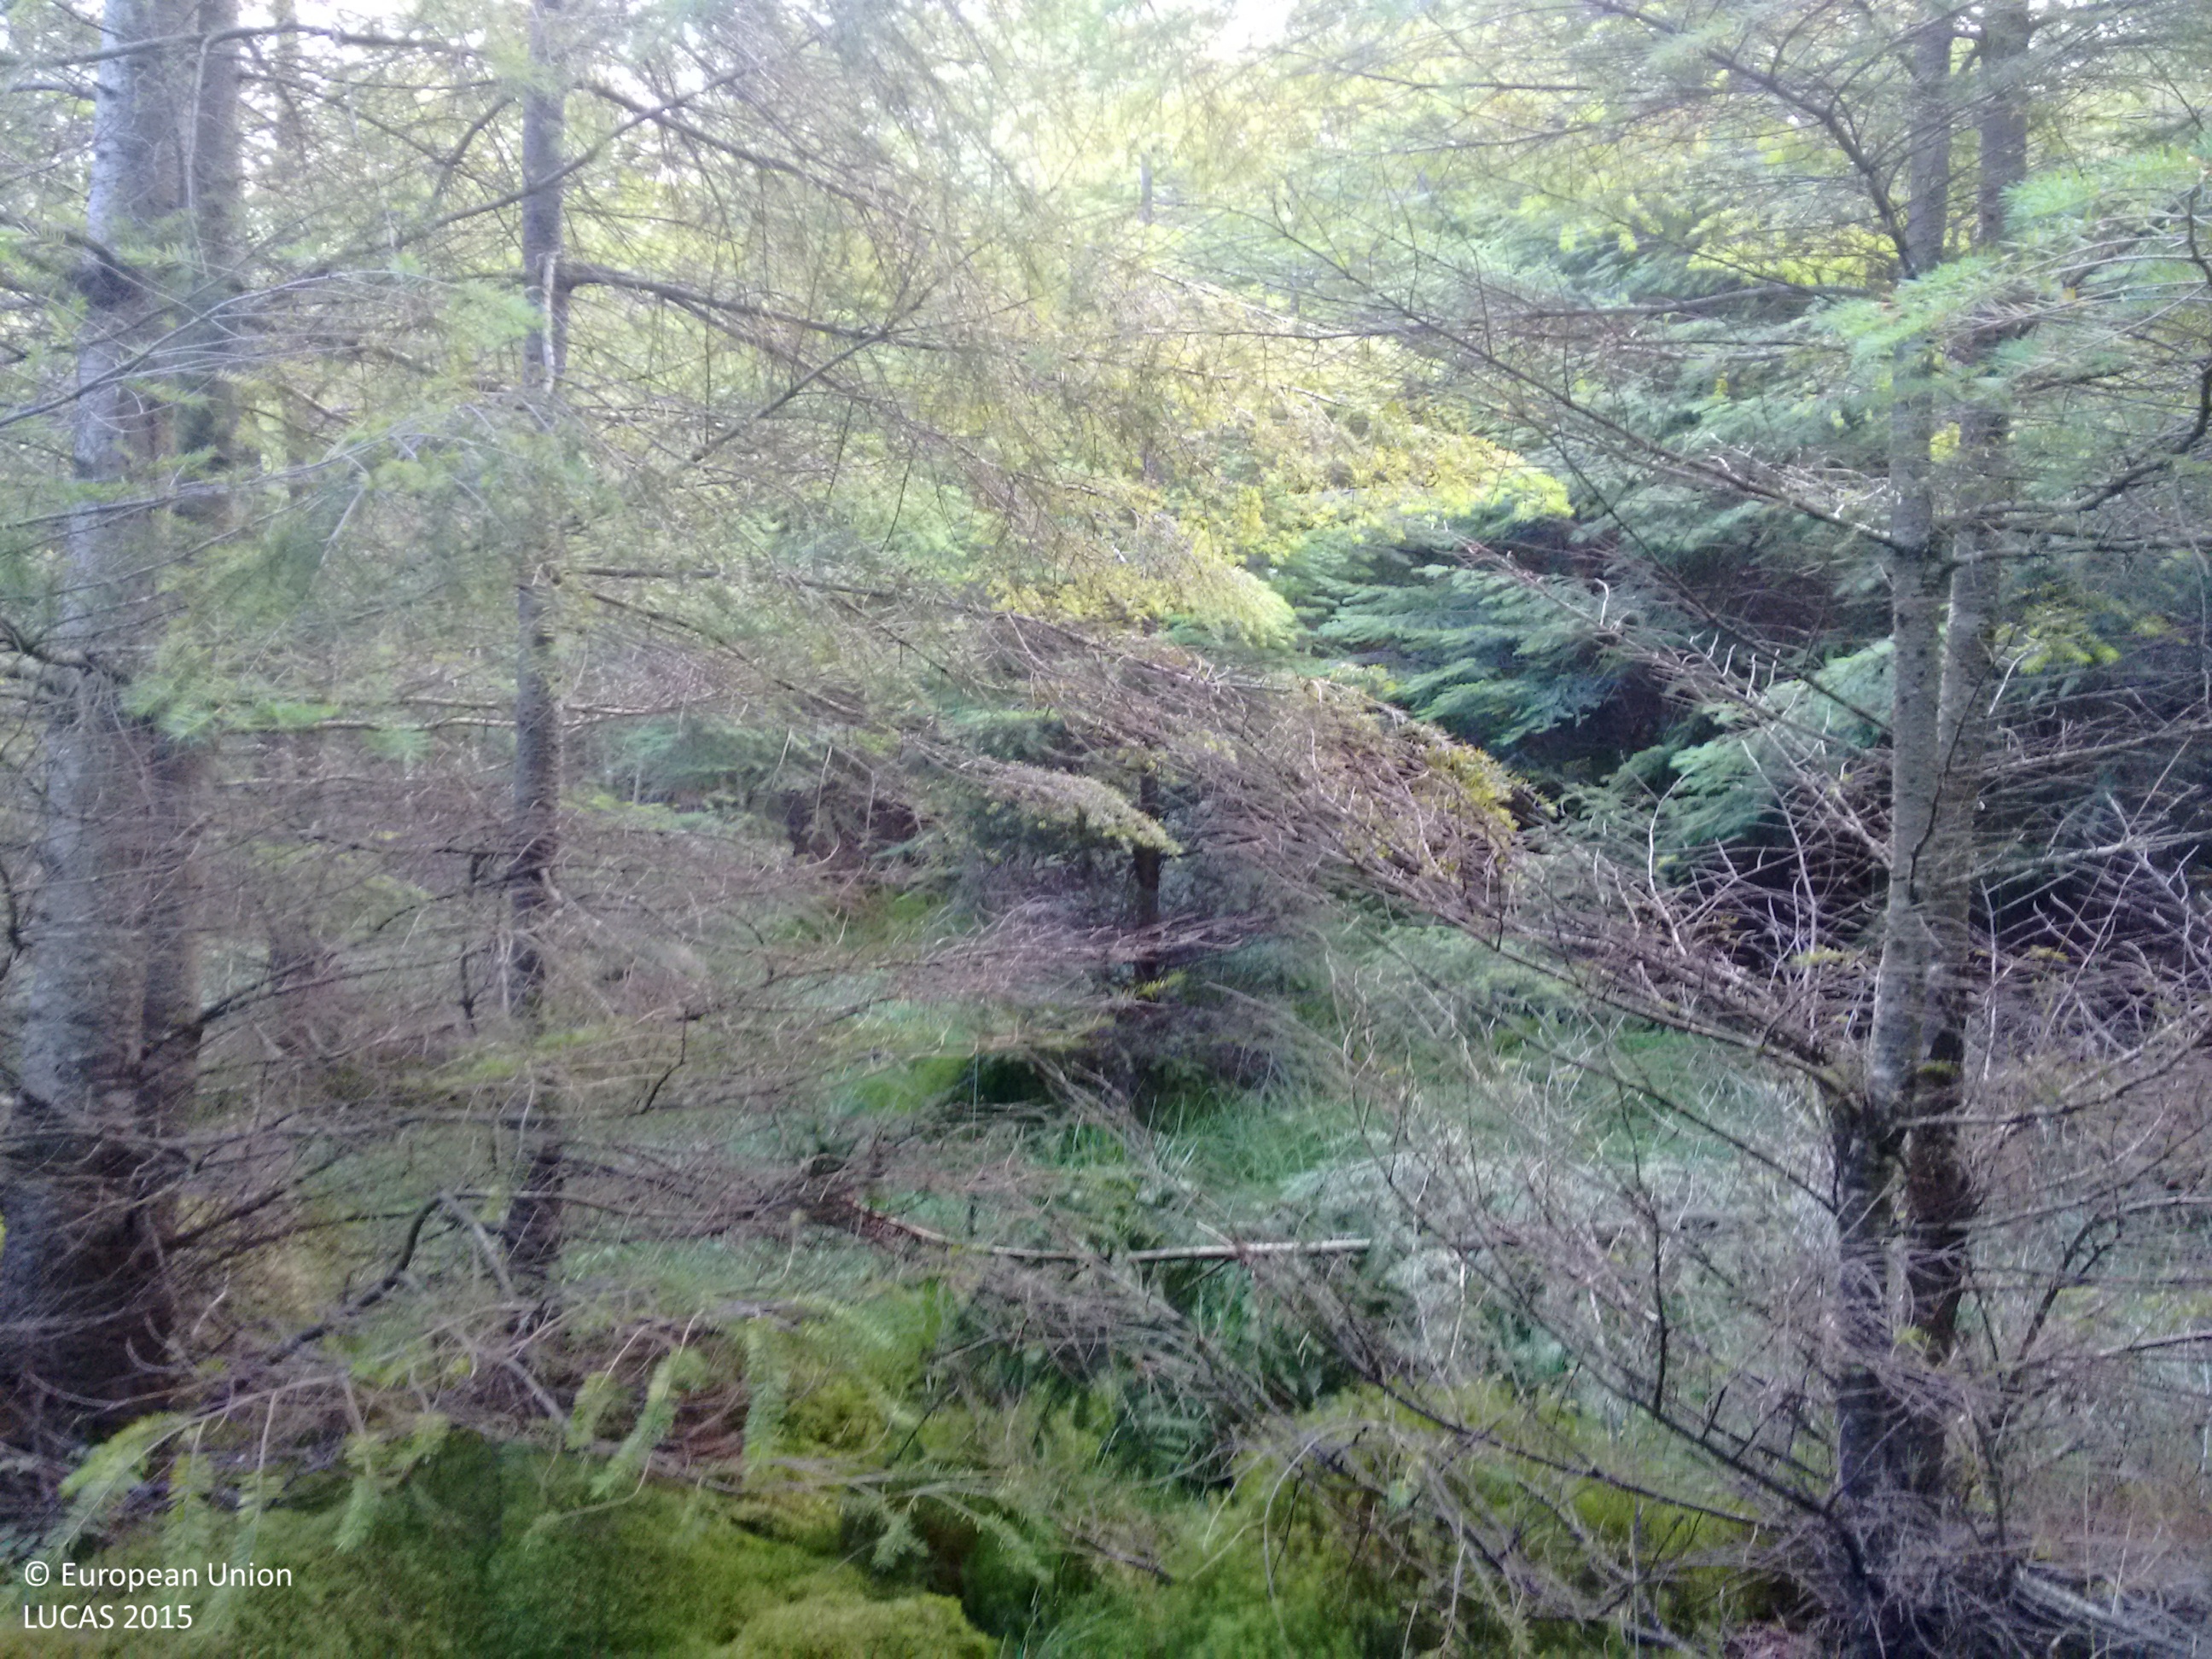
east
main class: Woodland
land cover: Spruce dominated coniferous woodland
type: exotic forest
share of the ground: > 75 %
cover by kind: coniferous forest trees 100 %
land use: Forestry
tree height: > 5 m
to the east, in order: Spruce dominated coniferous woodland; Ditches and canals; Spruce dominated coniferous woodland; Fences; Broadleaved woodland; Inland fresh running water; Lines of trees; Grassland without tree/shrub cover
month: September
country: GB
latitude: 57.6445
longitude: -4.6868
